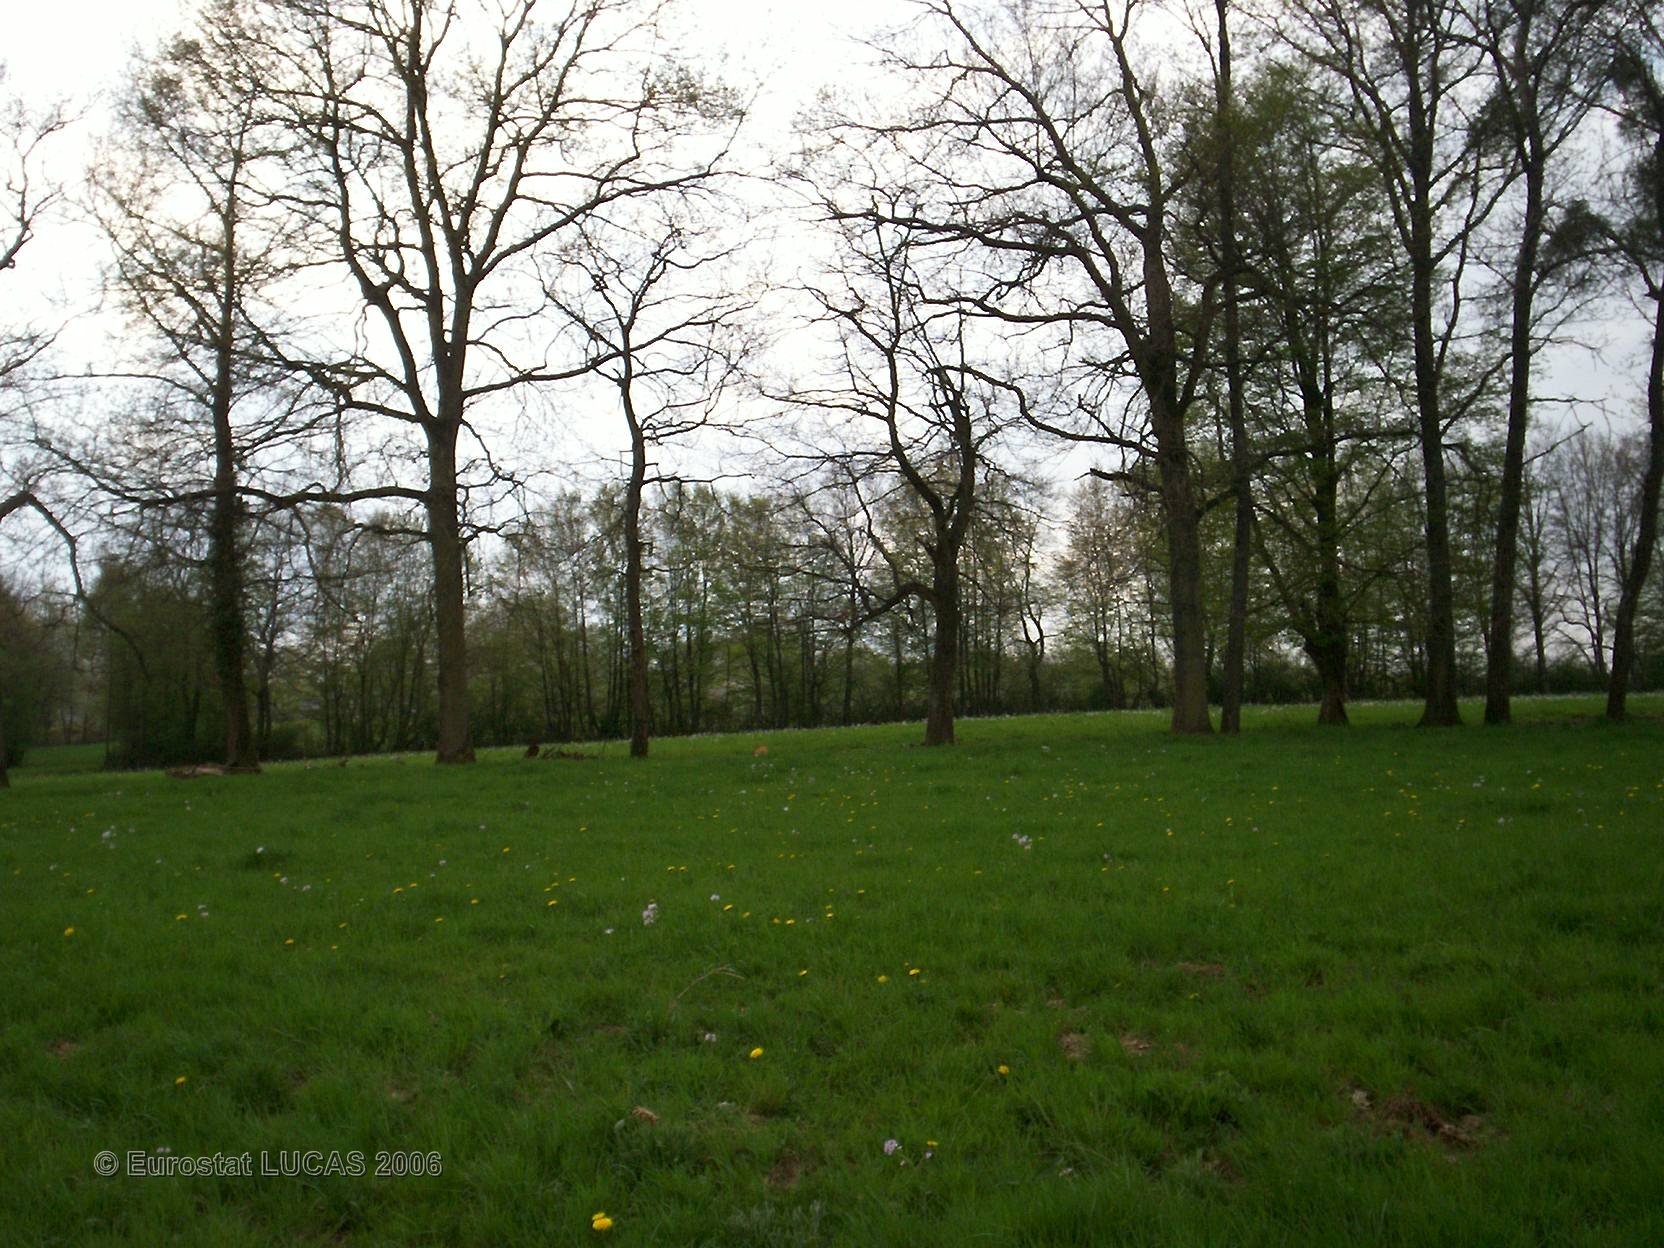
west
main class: Grassland
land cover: Grassland without tree/shrub cover
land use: Agriculture (excluding fallow land and kitchen gardens)
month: April
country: FR
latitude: 49.7045
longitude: 4.4079
